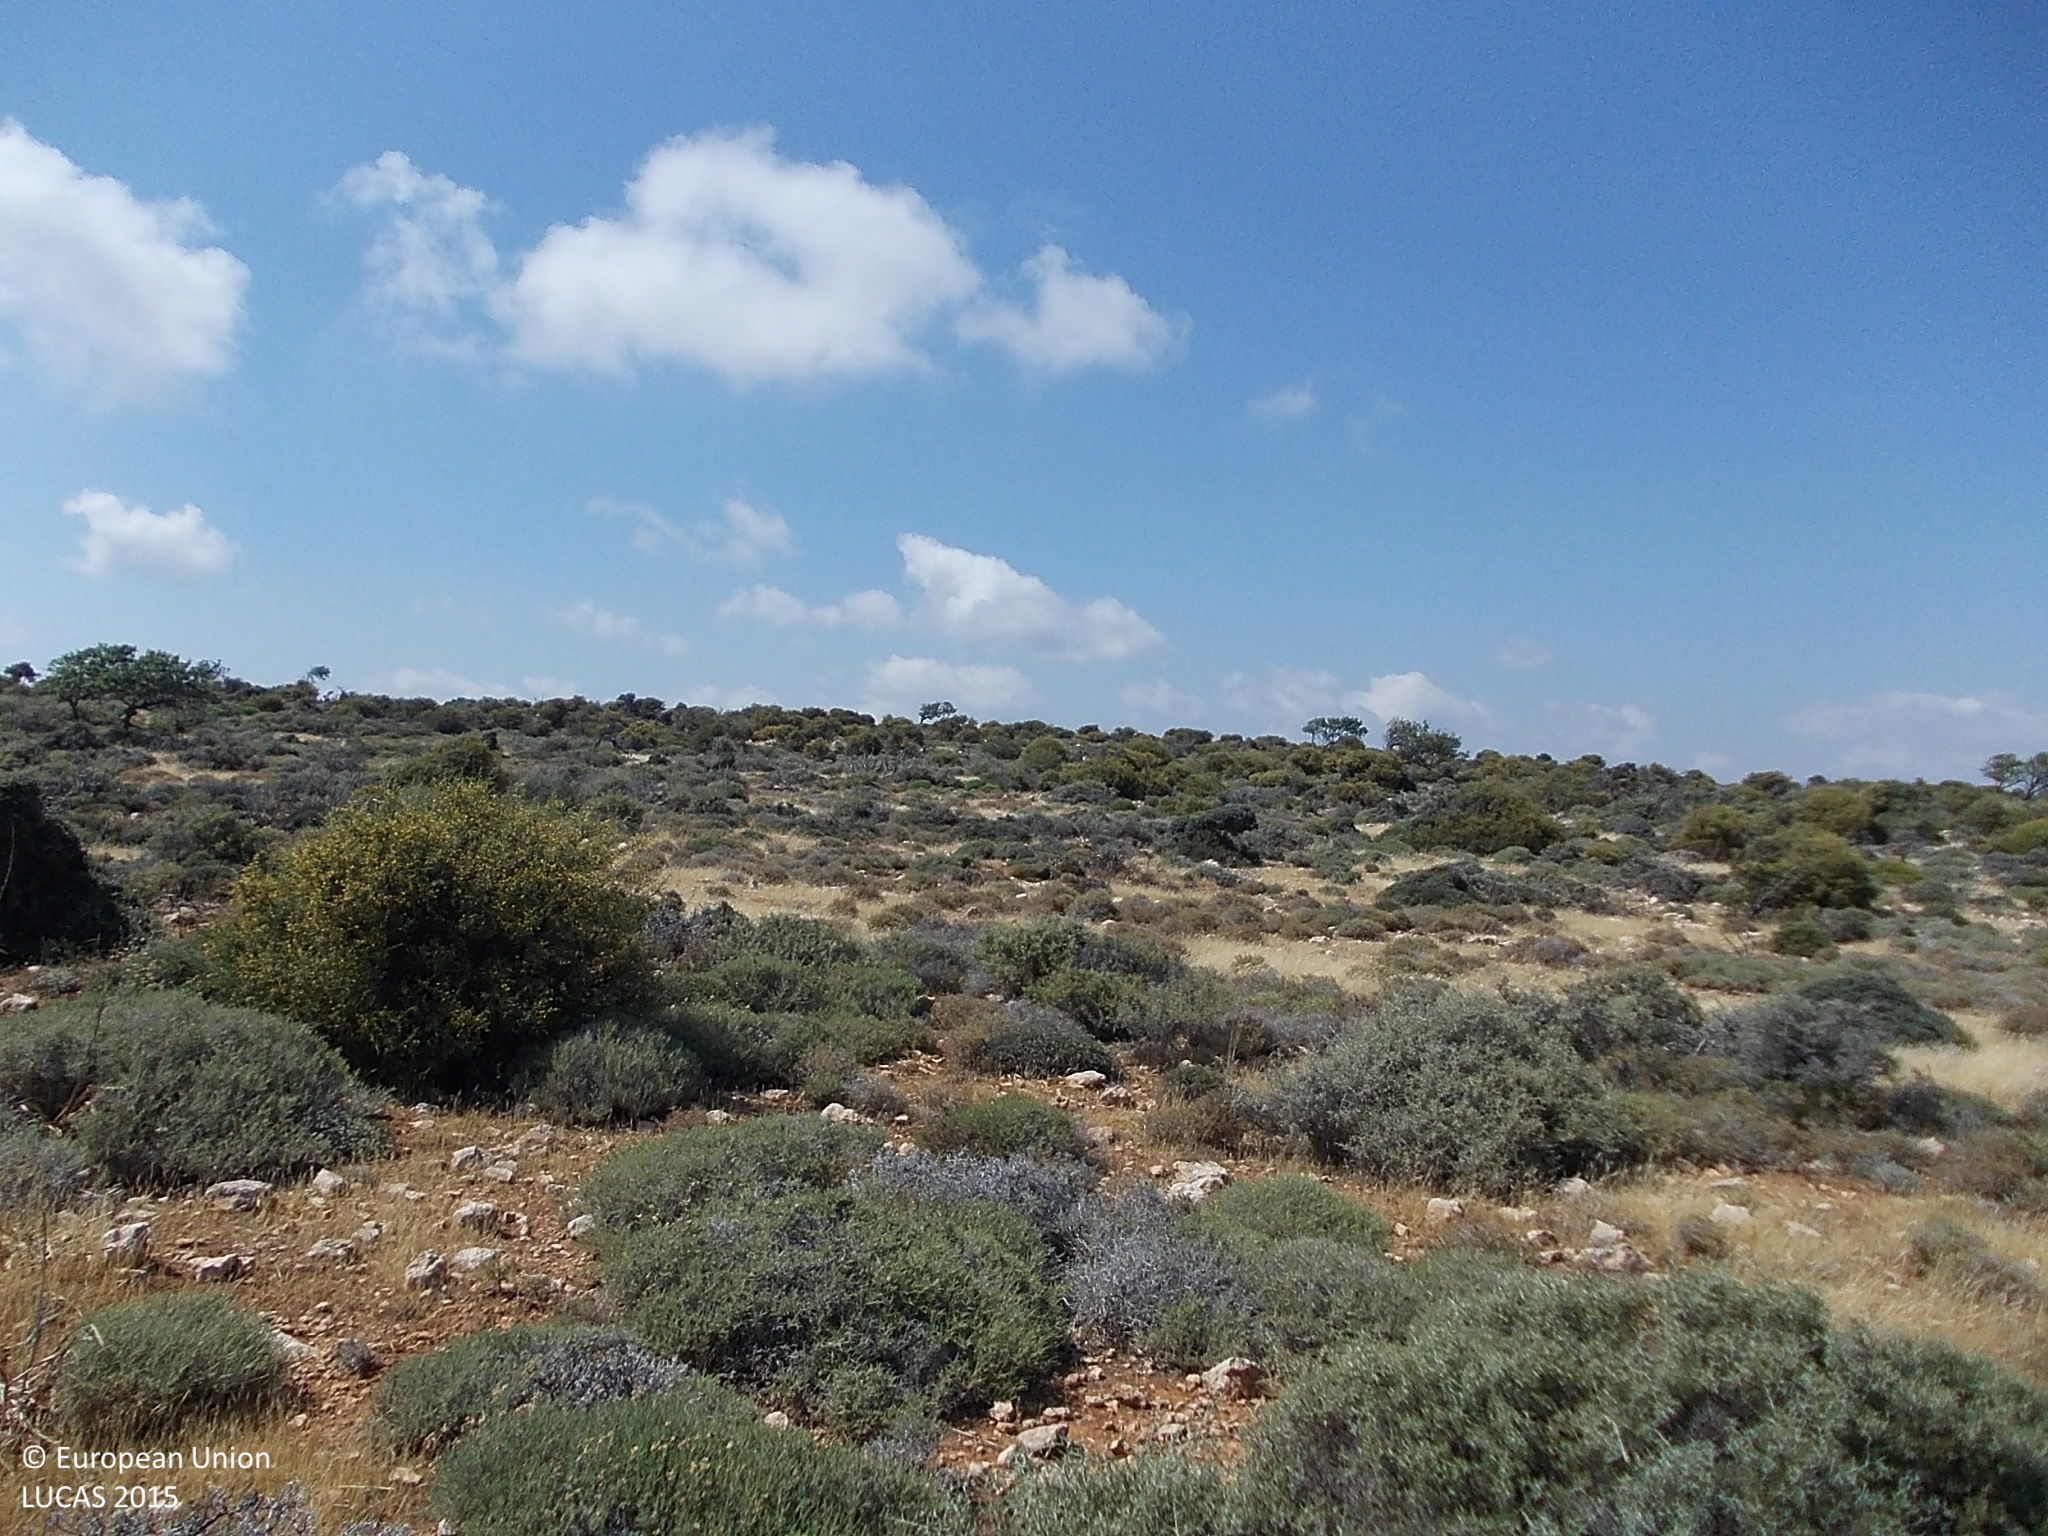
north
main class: Shrubland
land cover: Shrubland without tree cover
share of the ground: > 75 %
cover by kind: shrubs 75 %, unconsolidated bare surface 15 %, herbaceous plants 10 %
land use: Semi-natural and natural areas not in use
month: June
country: CY
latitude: 34.6450
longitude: 32.7012
